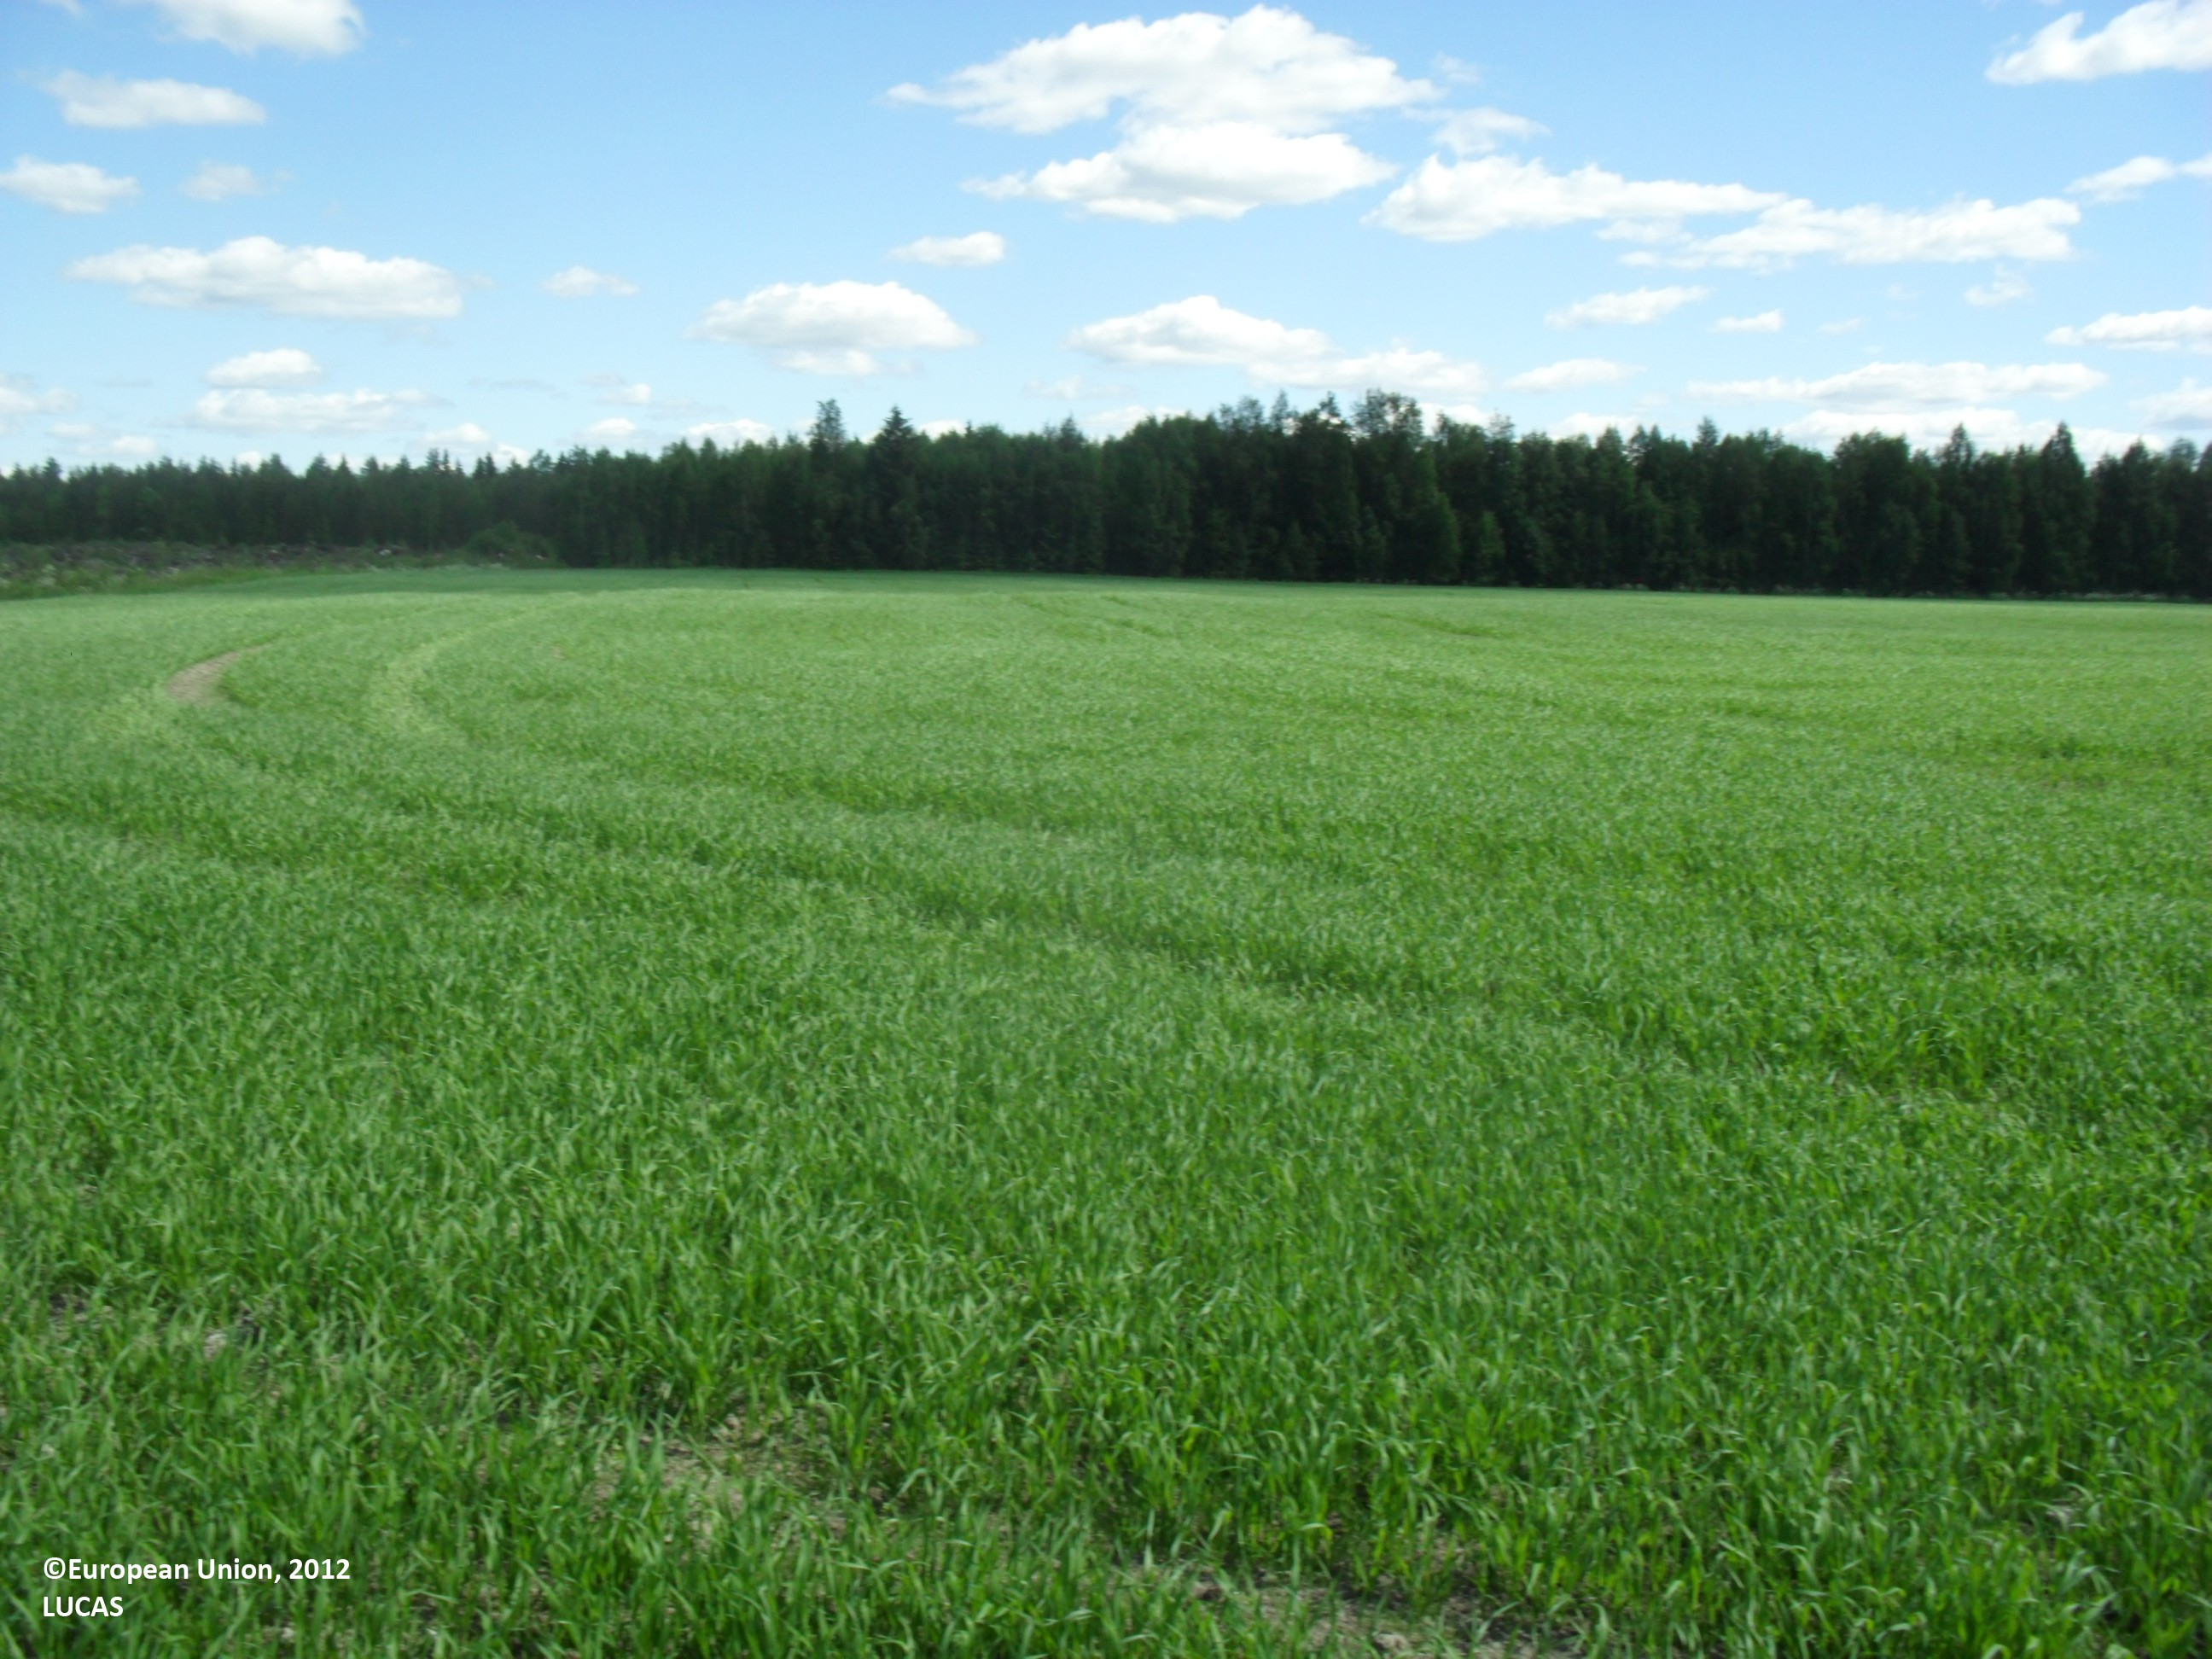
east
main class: Cropland
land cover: Oats
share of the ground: 50 - 75 %
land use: Agriculture (excluding fallow land and kitchen gardens)
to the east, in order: Oats; Grass margins; Rivers and streams; Broadleaved woodland; Shrubland with sparse tree cover; Grassland with sparse tree/shrub cover
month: June
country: FI
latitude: 63.2888
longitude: 23.0382
